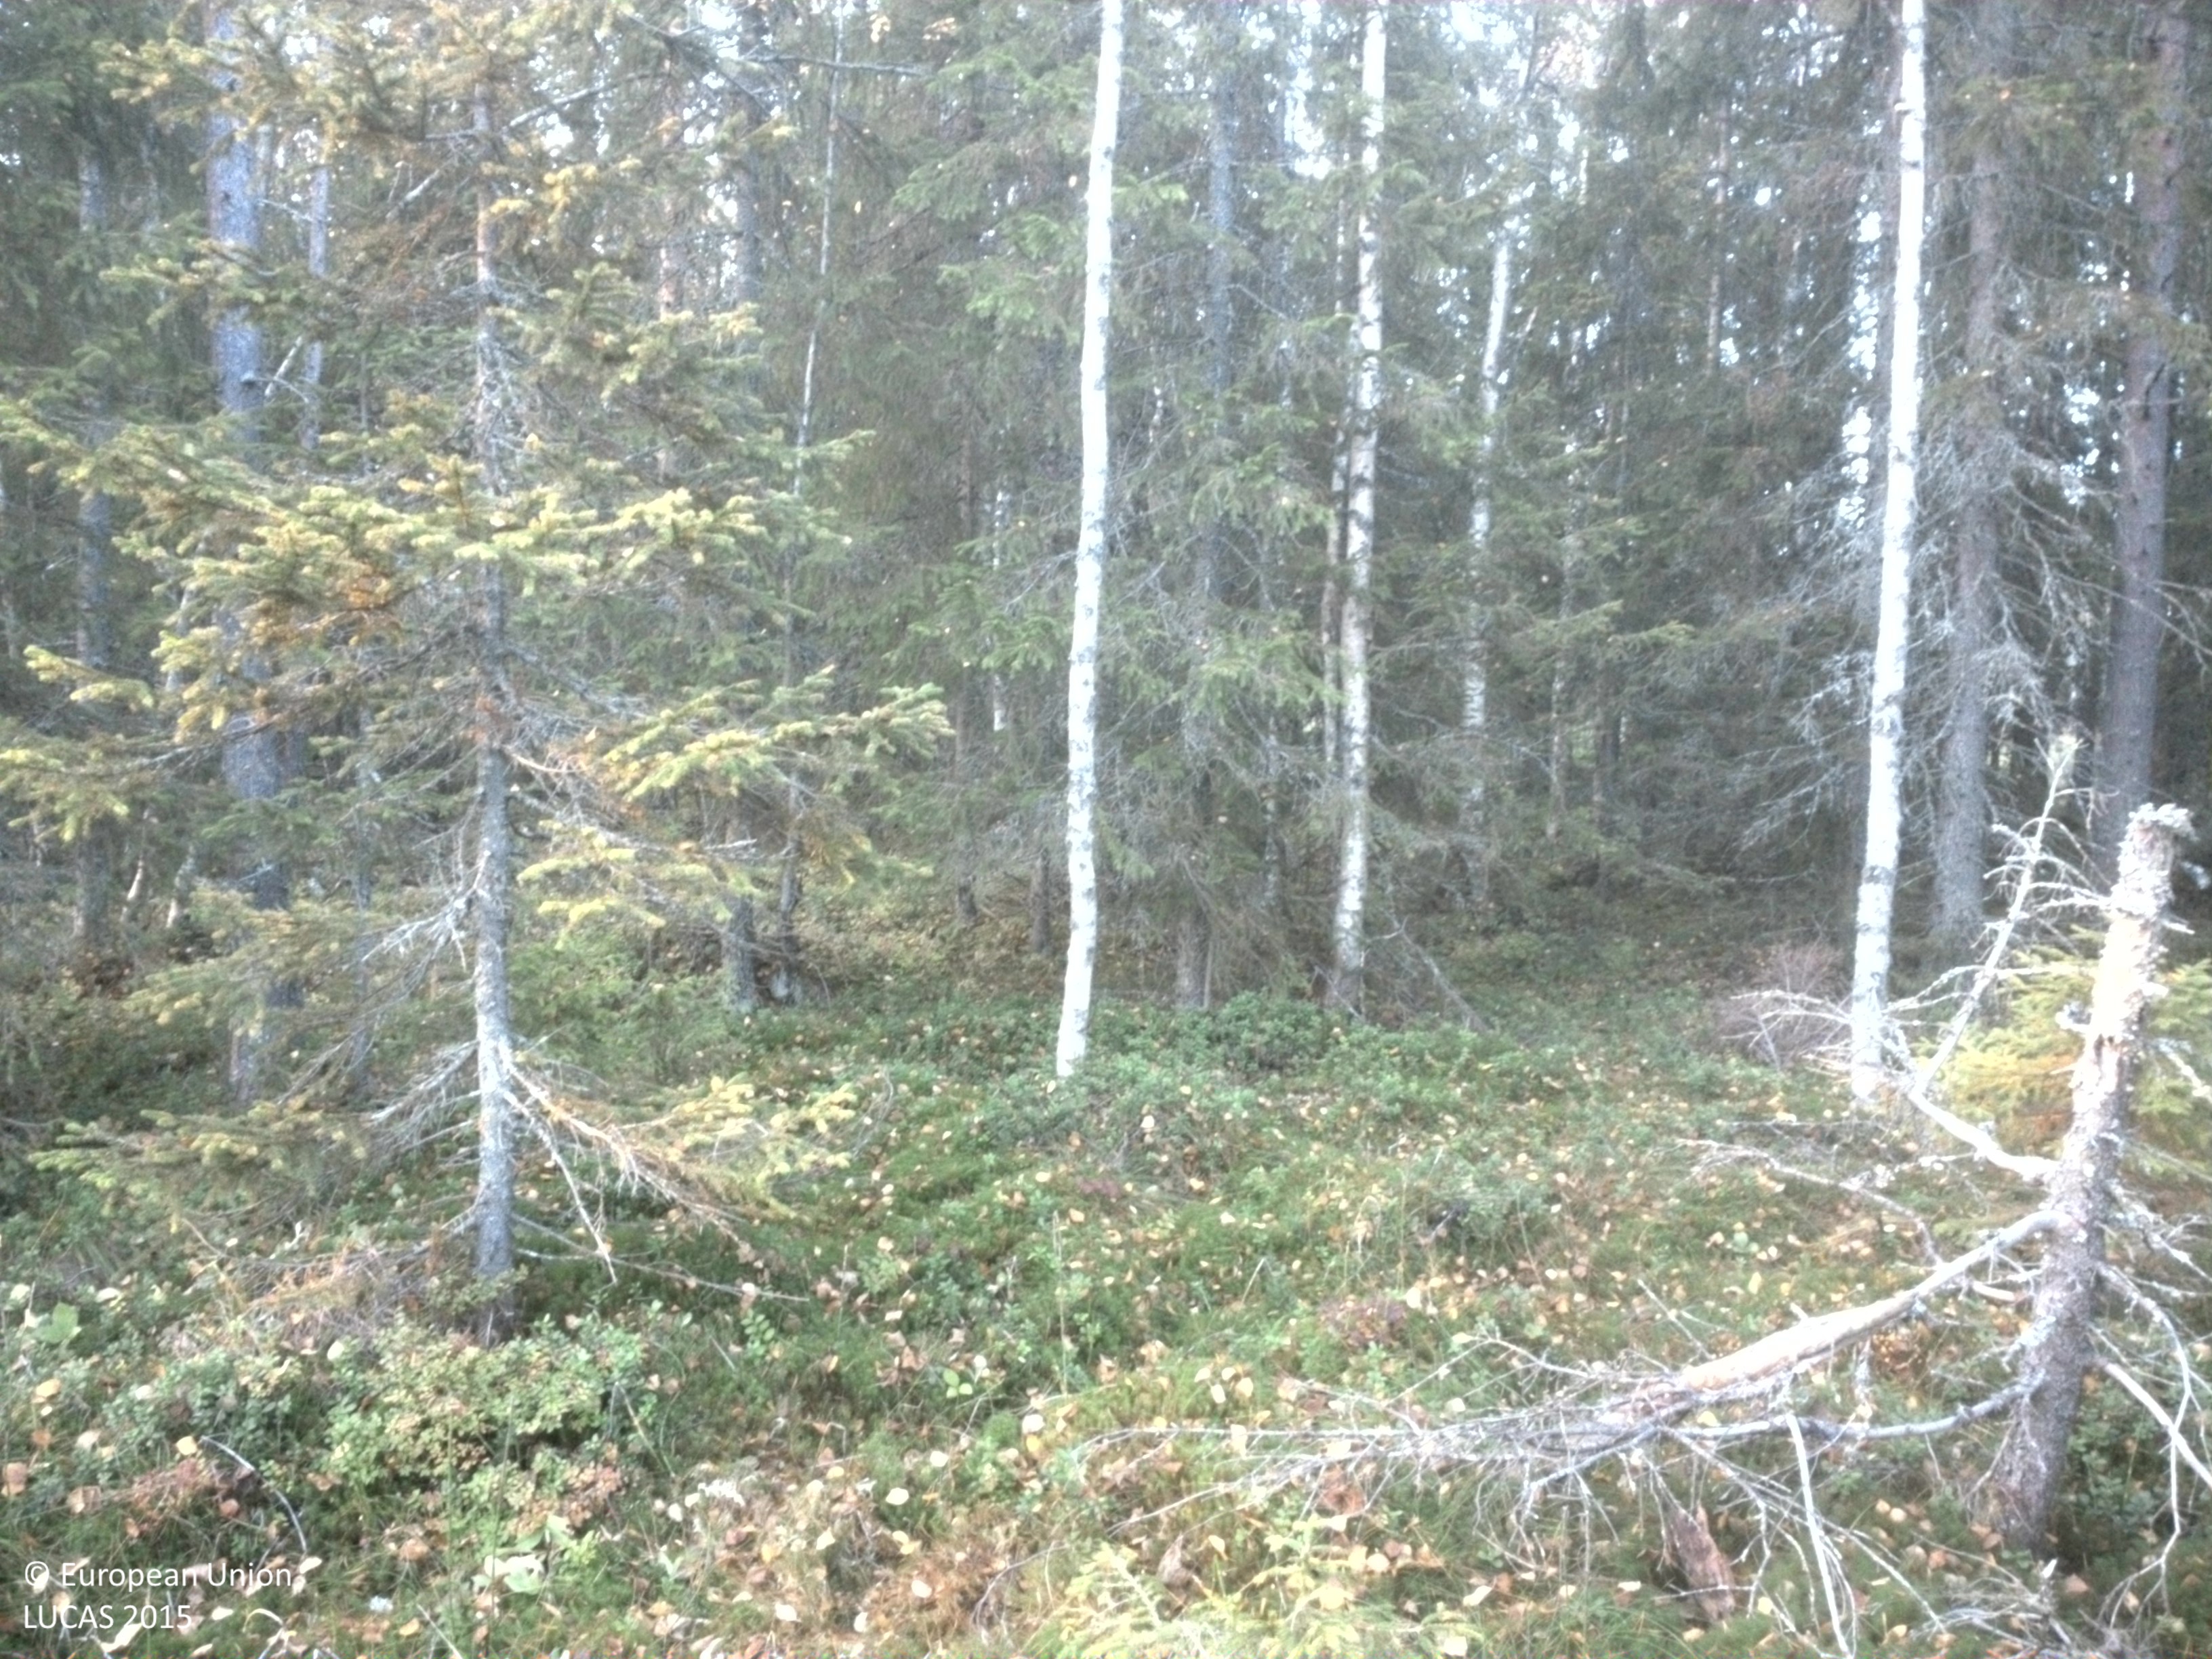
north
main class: Woodland
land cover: Other mixed woodland
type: boreal forest
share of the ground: 50 - 75 %
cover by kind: coniferous forest trees 45 %, broadleaved forest trees 20 %, shrubs 20 %, lichens and mosses 10 %, herbaceous plants 5 %
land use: Forestry
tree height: > 5 m
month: September
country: SE
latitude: 64.1681
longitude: 20.0772
